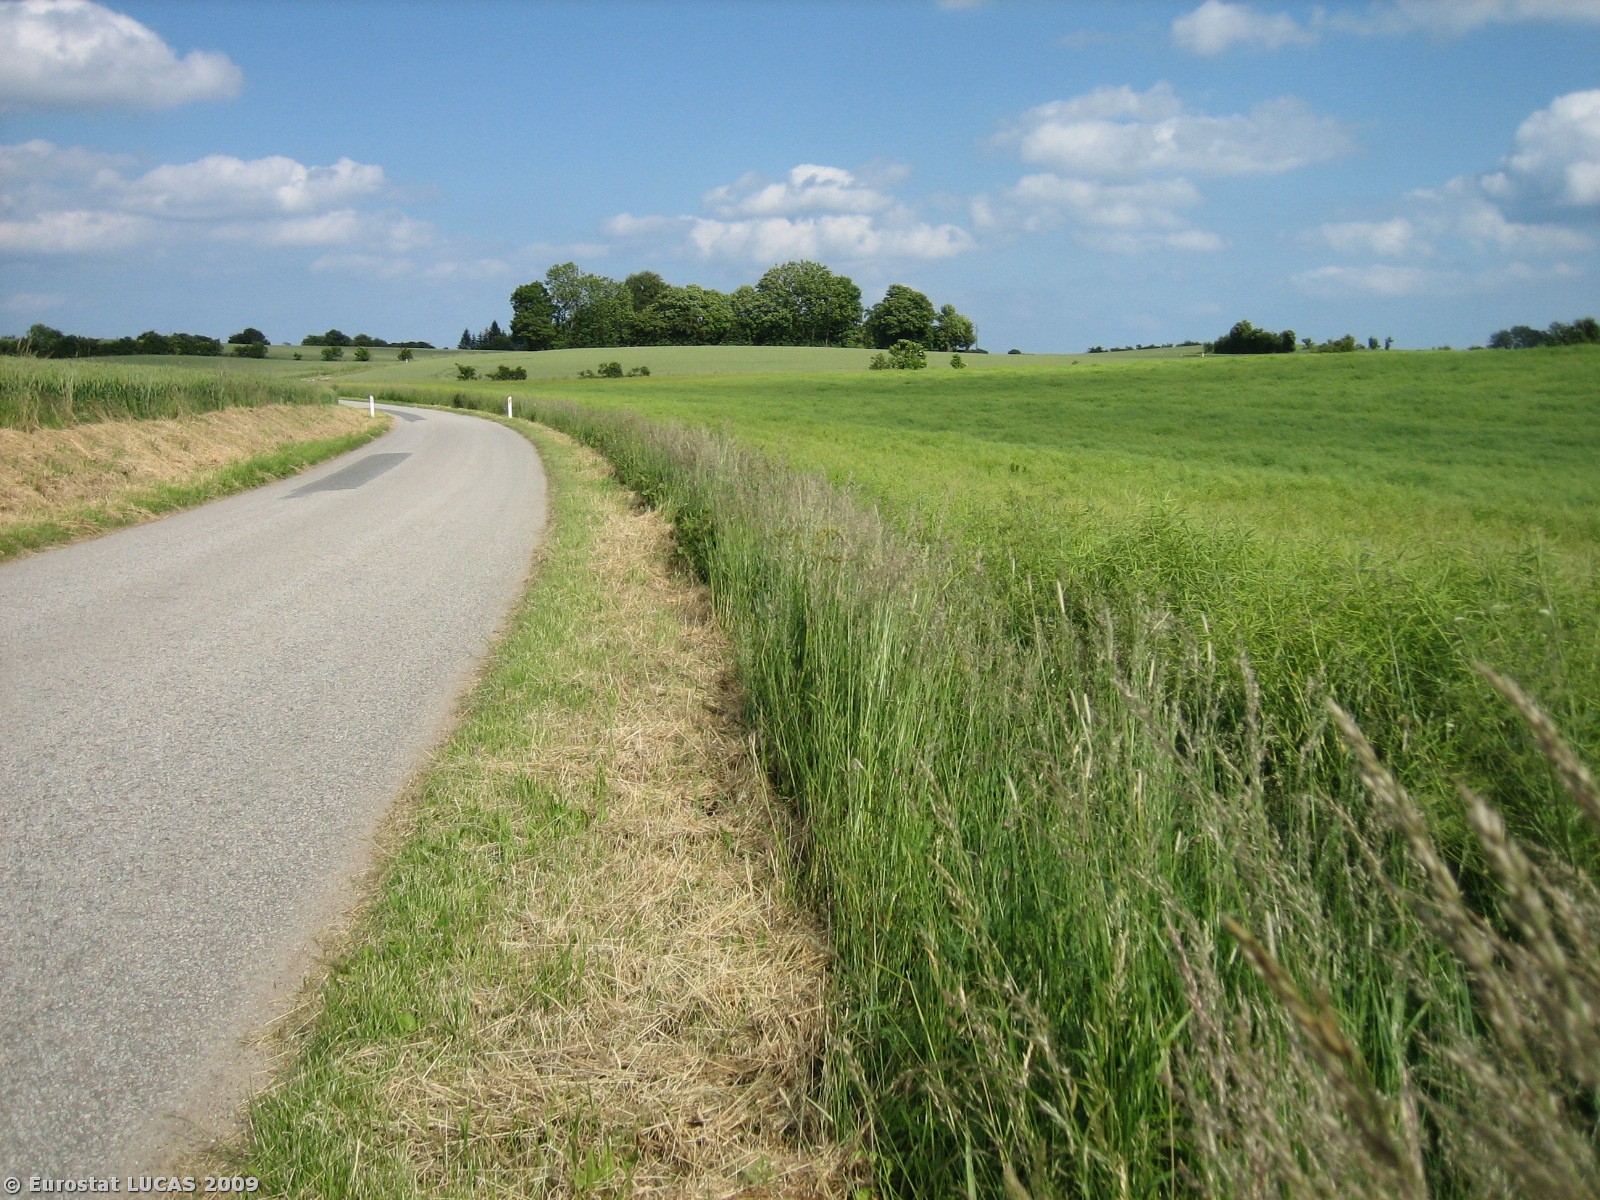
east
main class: Cropland
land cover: Rape and turnip rape
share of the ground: > 75 %
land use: Agriculture (excluding fallow land and kitchen gardens)
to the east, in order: Rape and turnip rape; Grassland with sparse tree/shrub cover; Common wheat
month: June
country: DK
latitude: 55.7563
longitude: 9.9841
